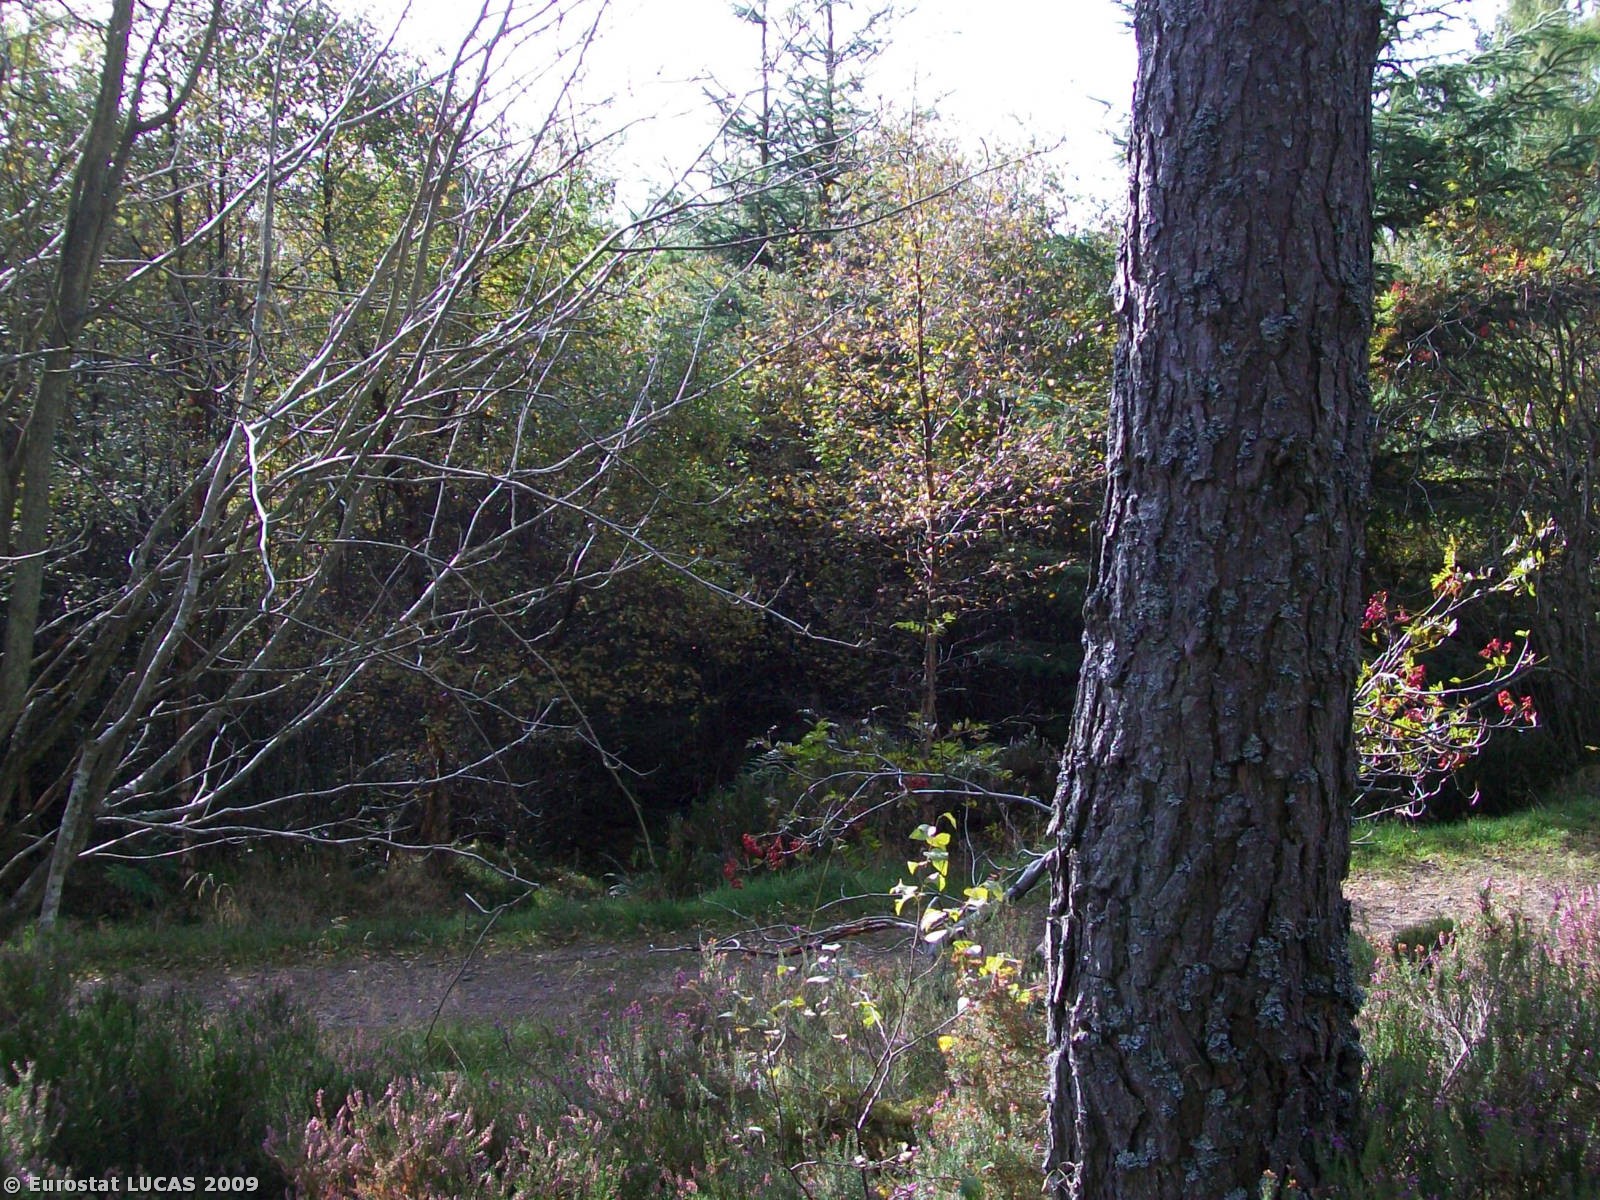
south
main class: Woodland
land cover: Coniferous woodland
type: plantations and self-sown exotic forest
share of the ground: 50 - 75 %
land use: Forestry
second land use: Forestry
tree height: > 5 m
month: September
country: GB
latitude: 57.2854
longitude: -2.5130
